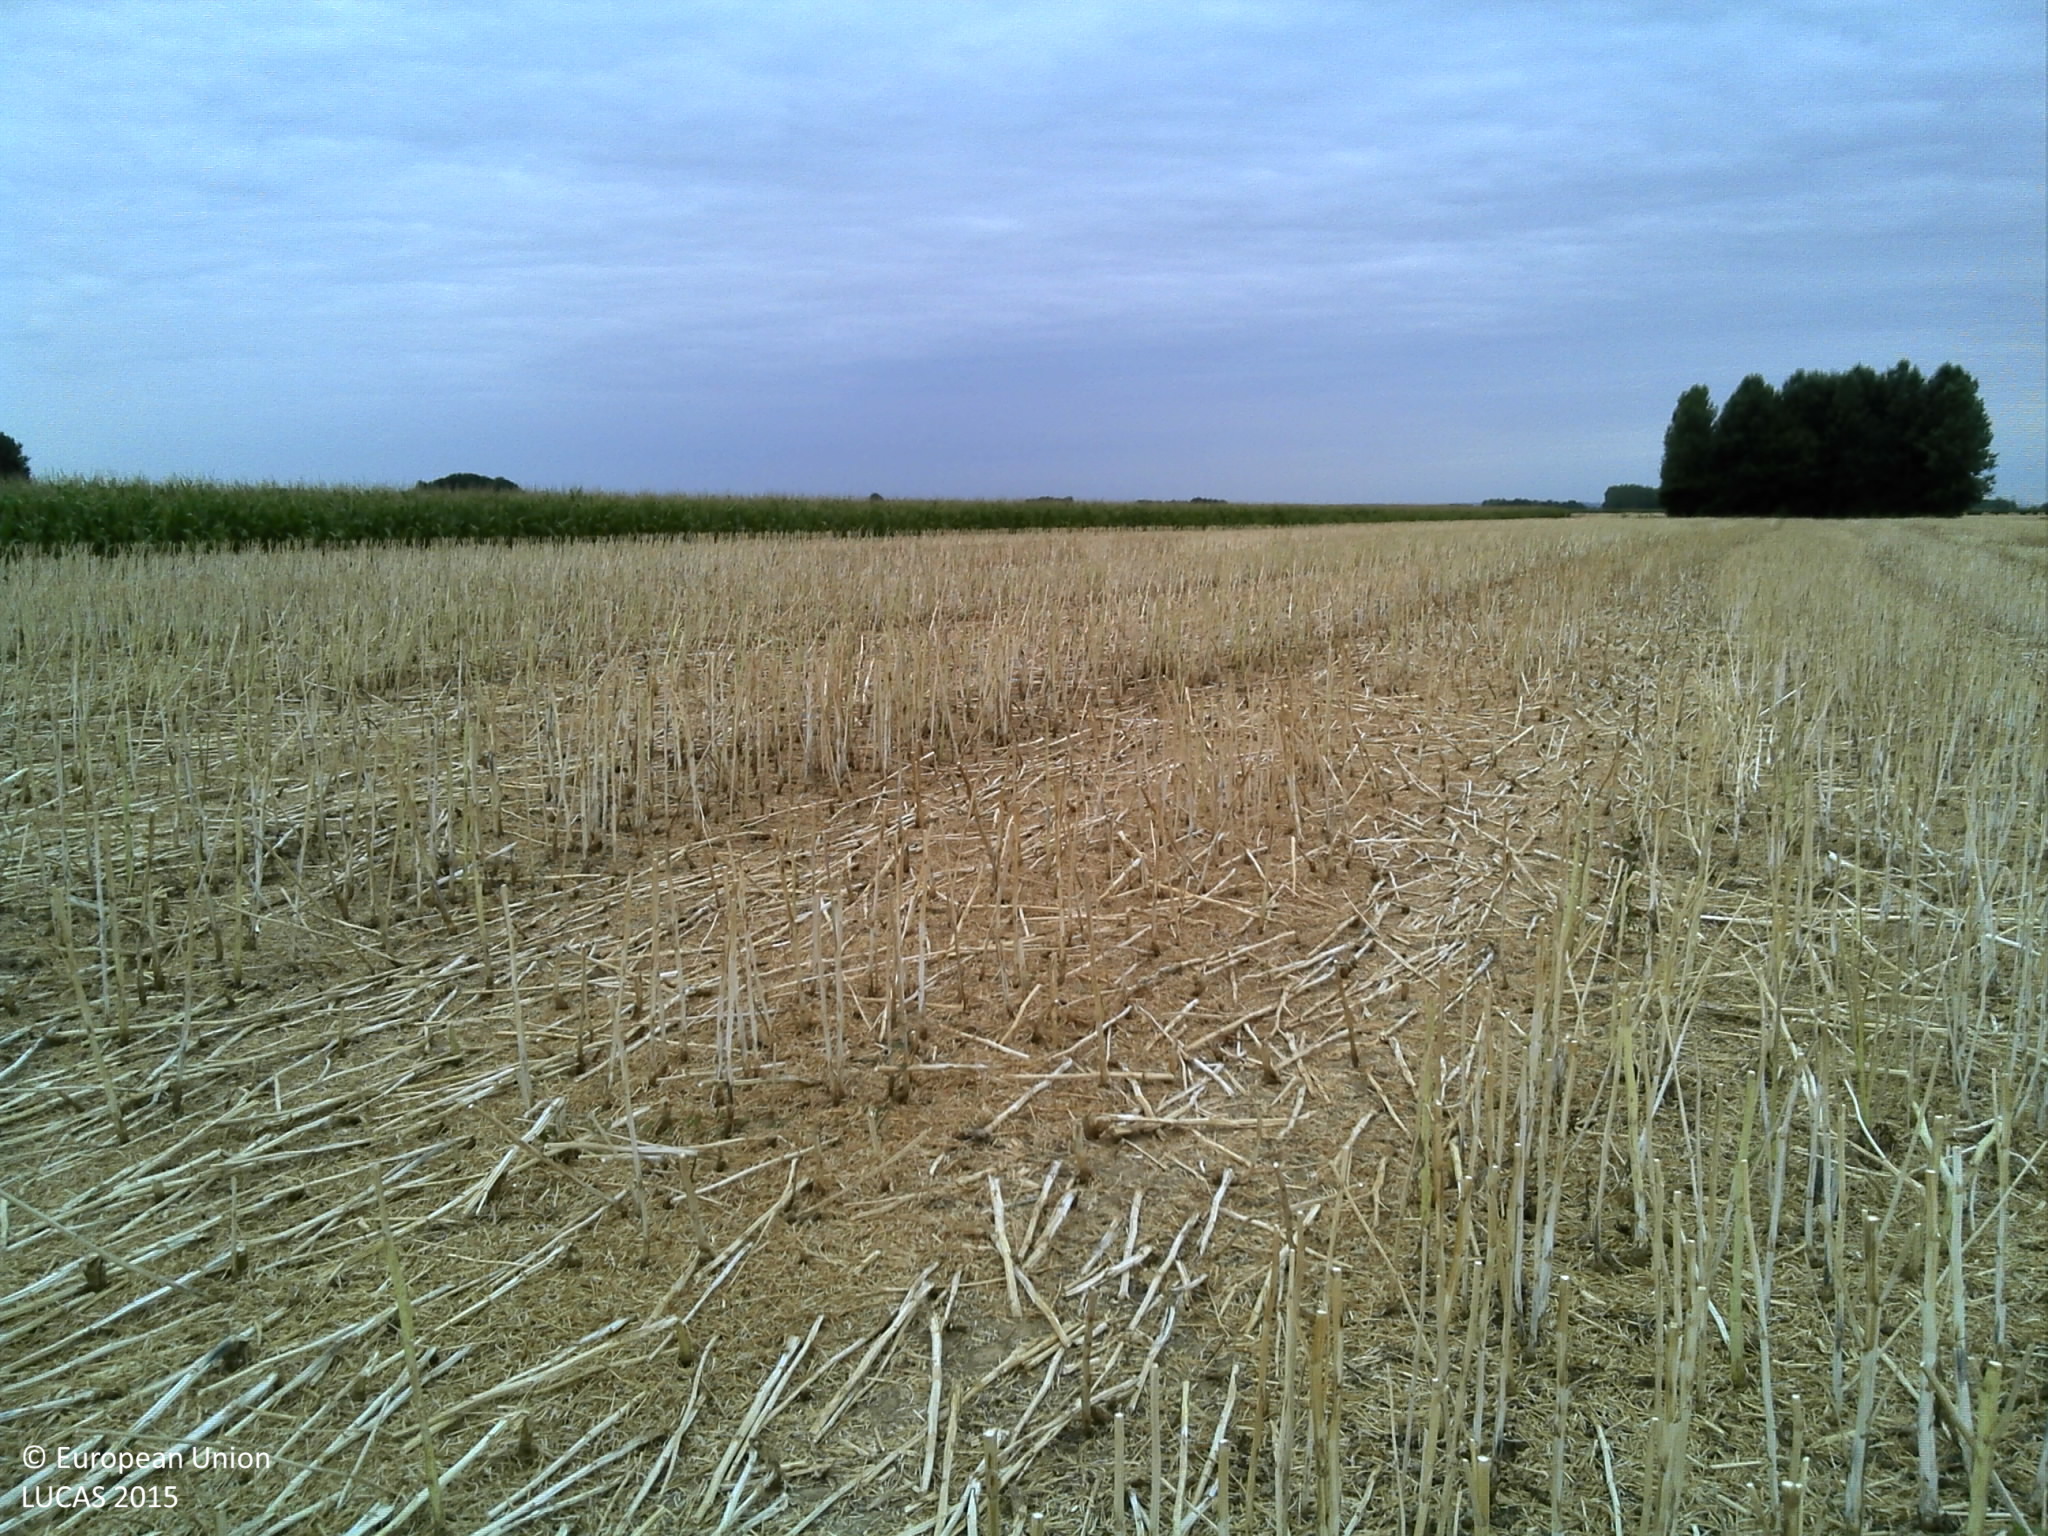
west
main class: Cropland
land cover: Rape and turnip rape
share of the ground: > 75 %
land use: Agriculture (excluding fallow land and kitchen gardens)
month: July
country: FR
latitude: 48.7110
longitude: 4.7381
